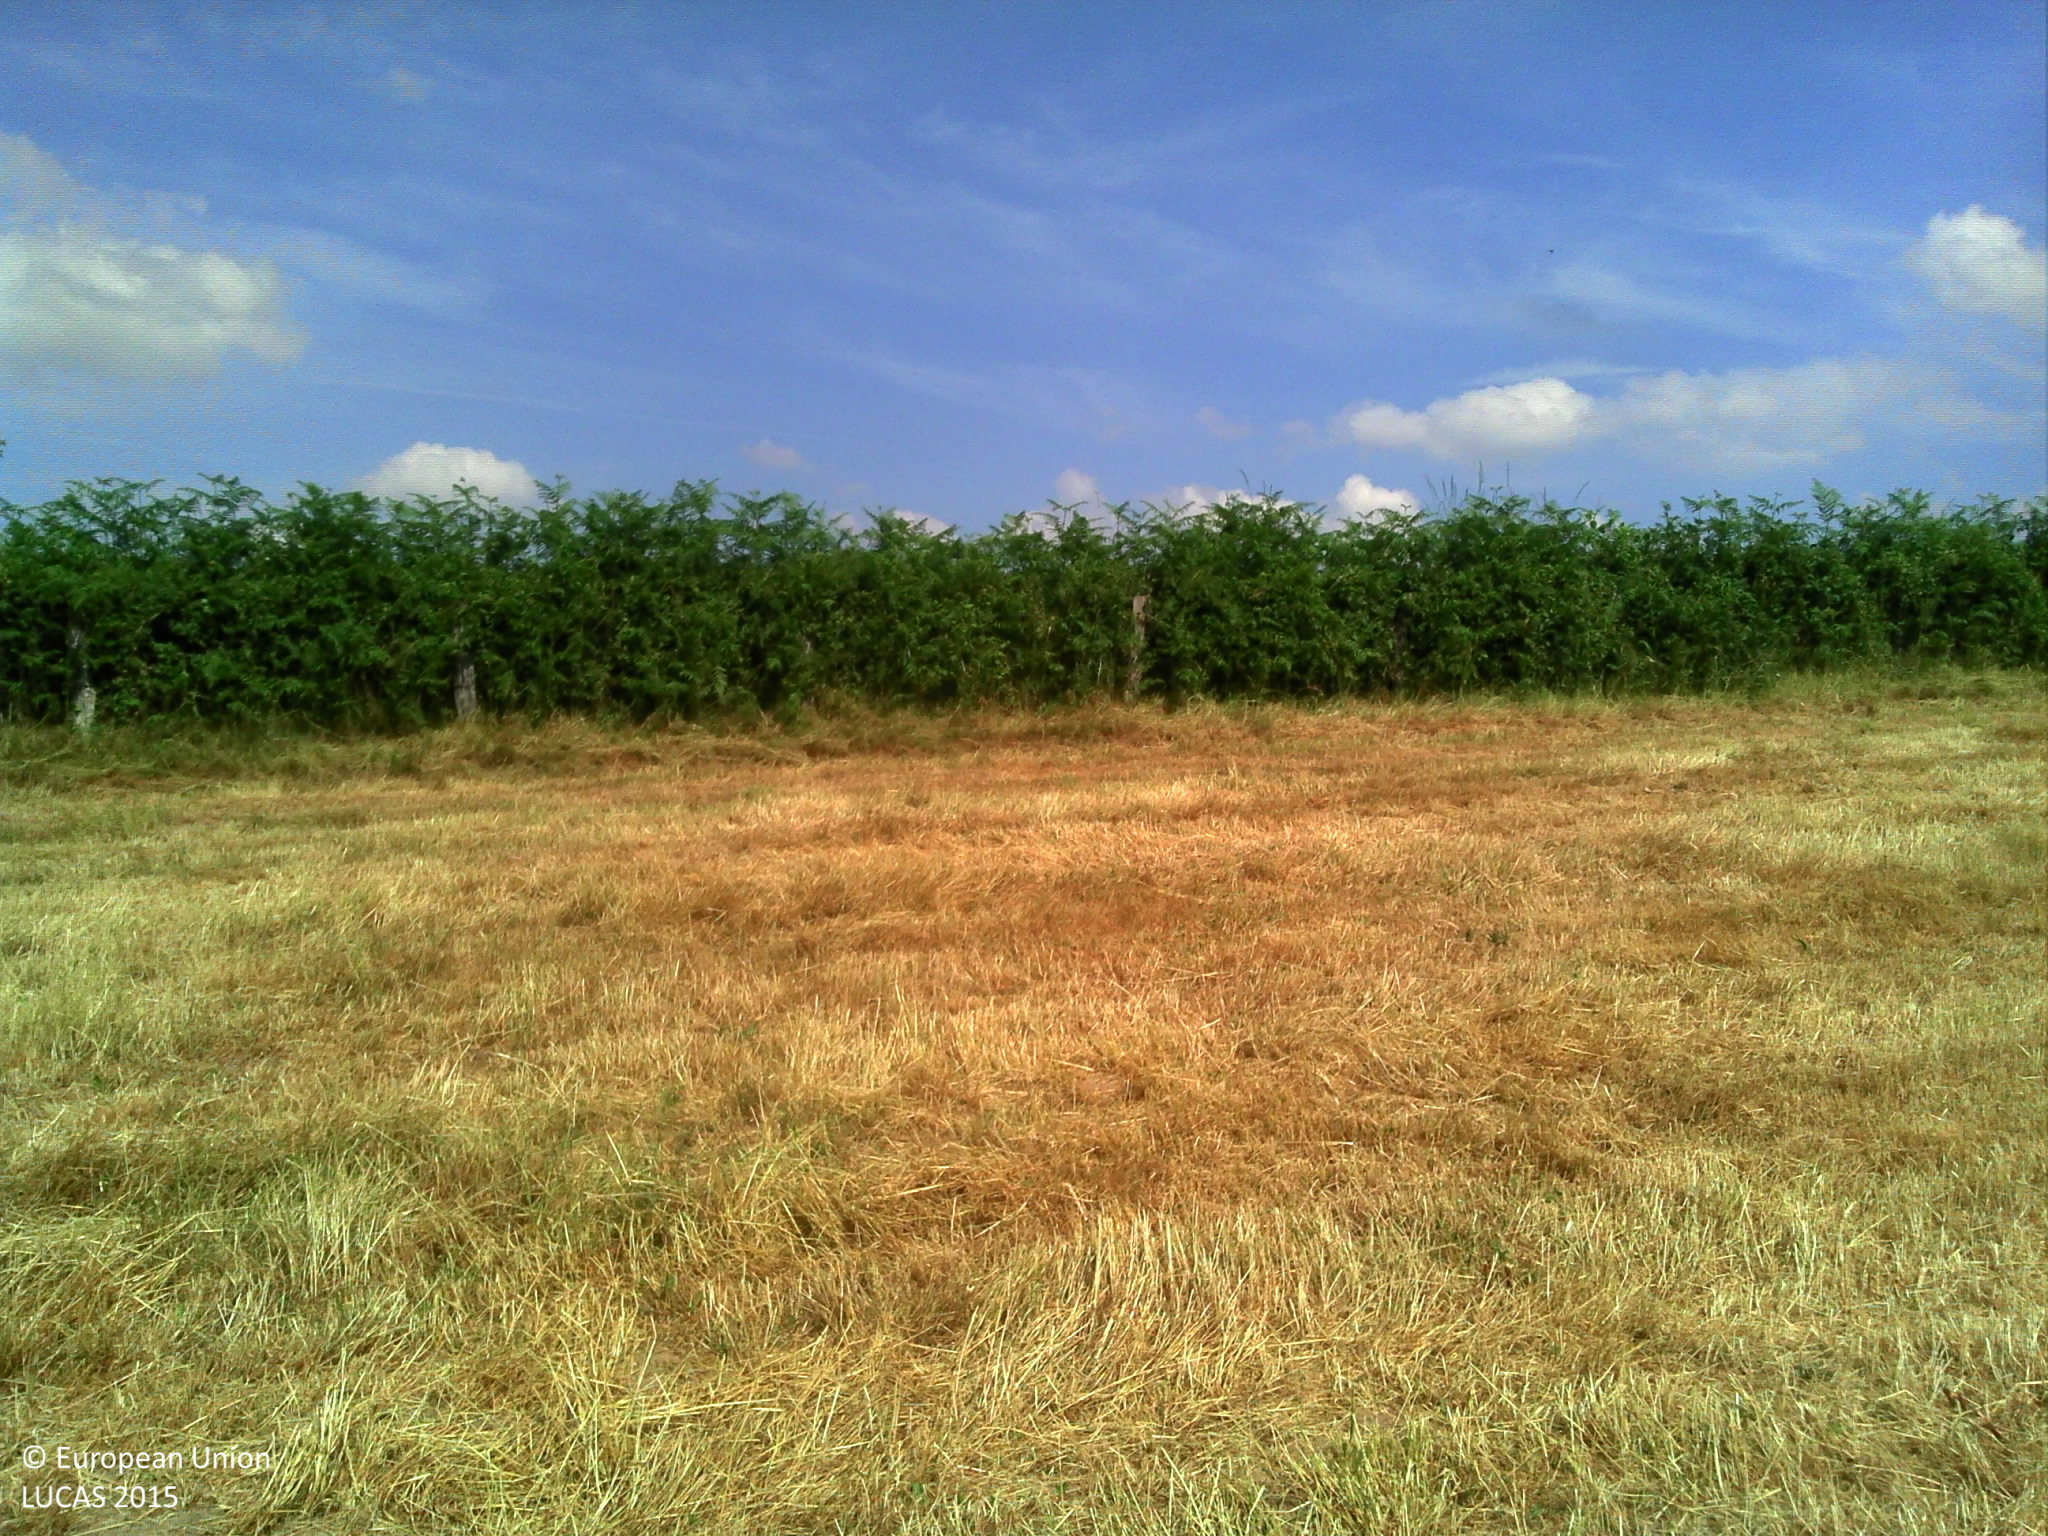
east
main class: Grassland
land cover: Grassland without tree/shrub cover
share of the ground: > 75 %
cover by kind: herbaceous plants 100 %
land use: Agriculture (excluding fallow land and kitchen gardens)
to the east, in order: Grassland without tree/shrub cover; Fences; Shruby margins; Paved roads, cycling and walking lanes; Managed hedges; Grassland without tree/shrub cover; Fences; Managed hedges; Fences; Grassland without tree/shrub cover
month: June
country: FR
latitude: 46.3670
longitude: 4.3990
